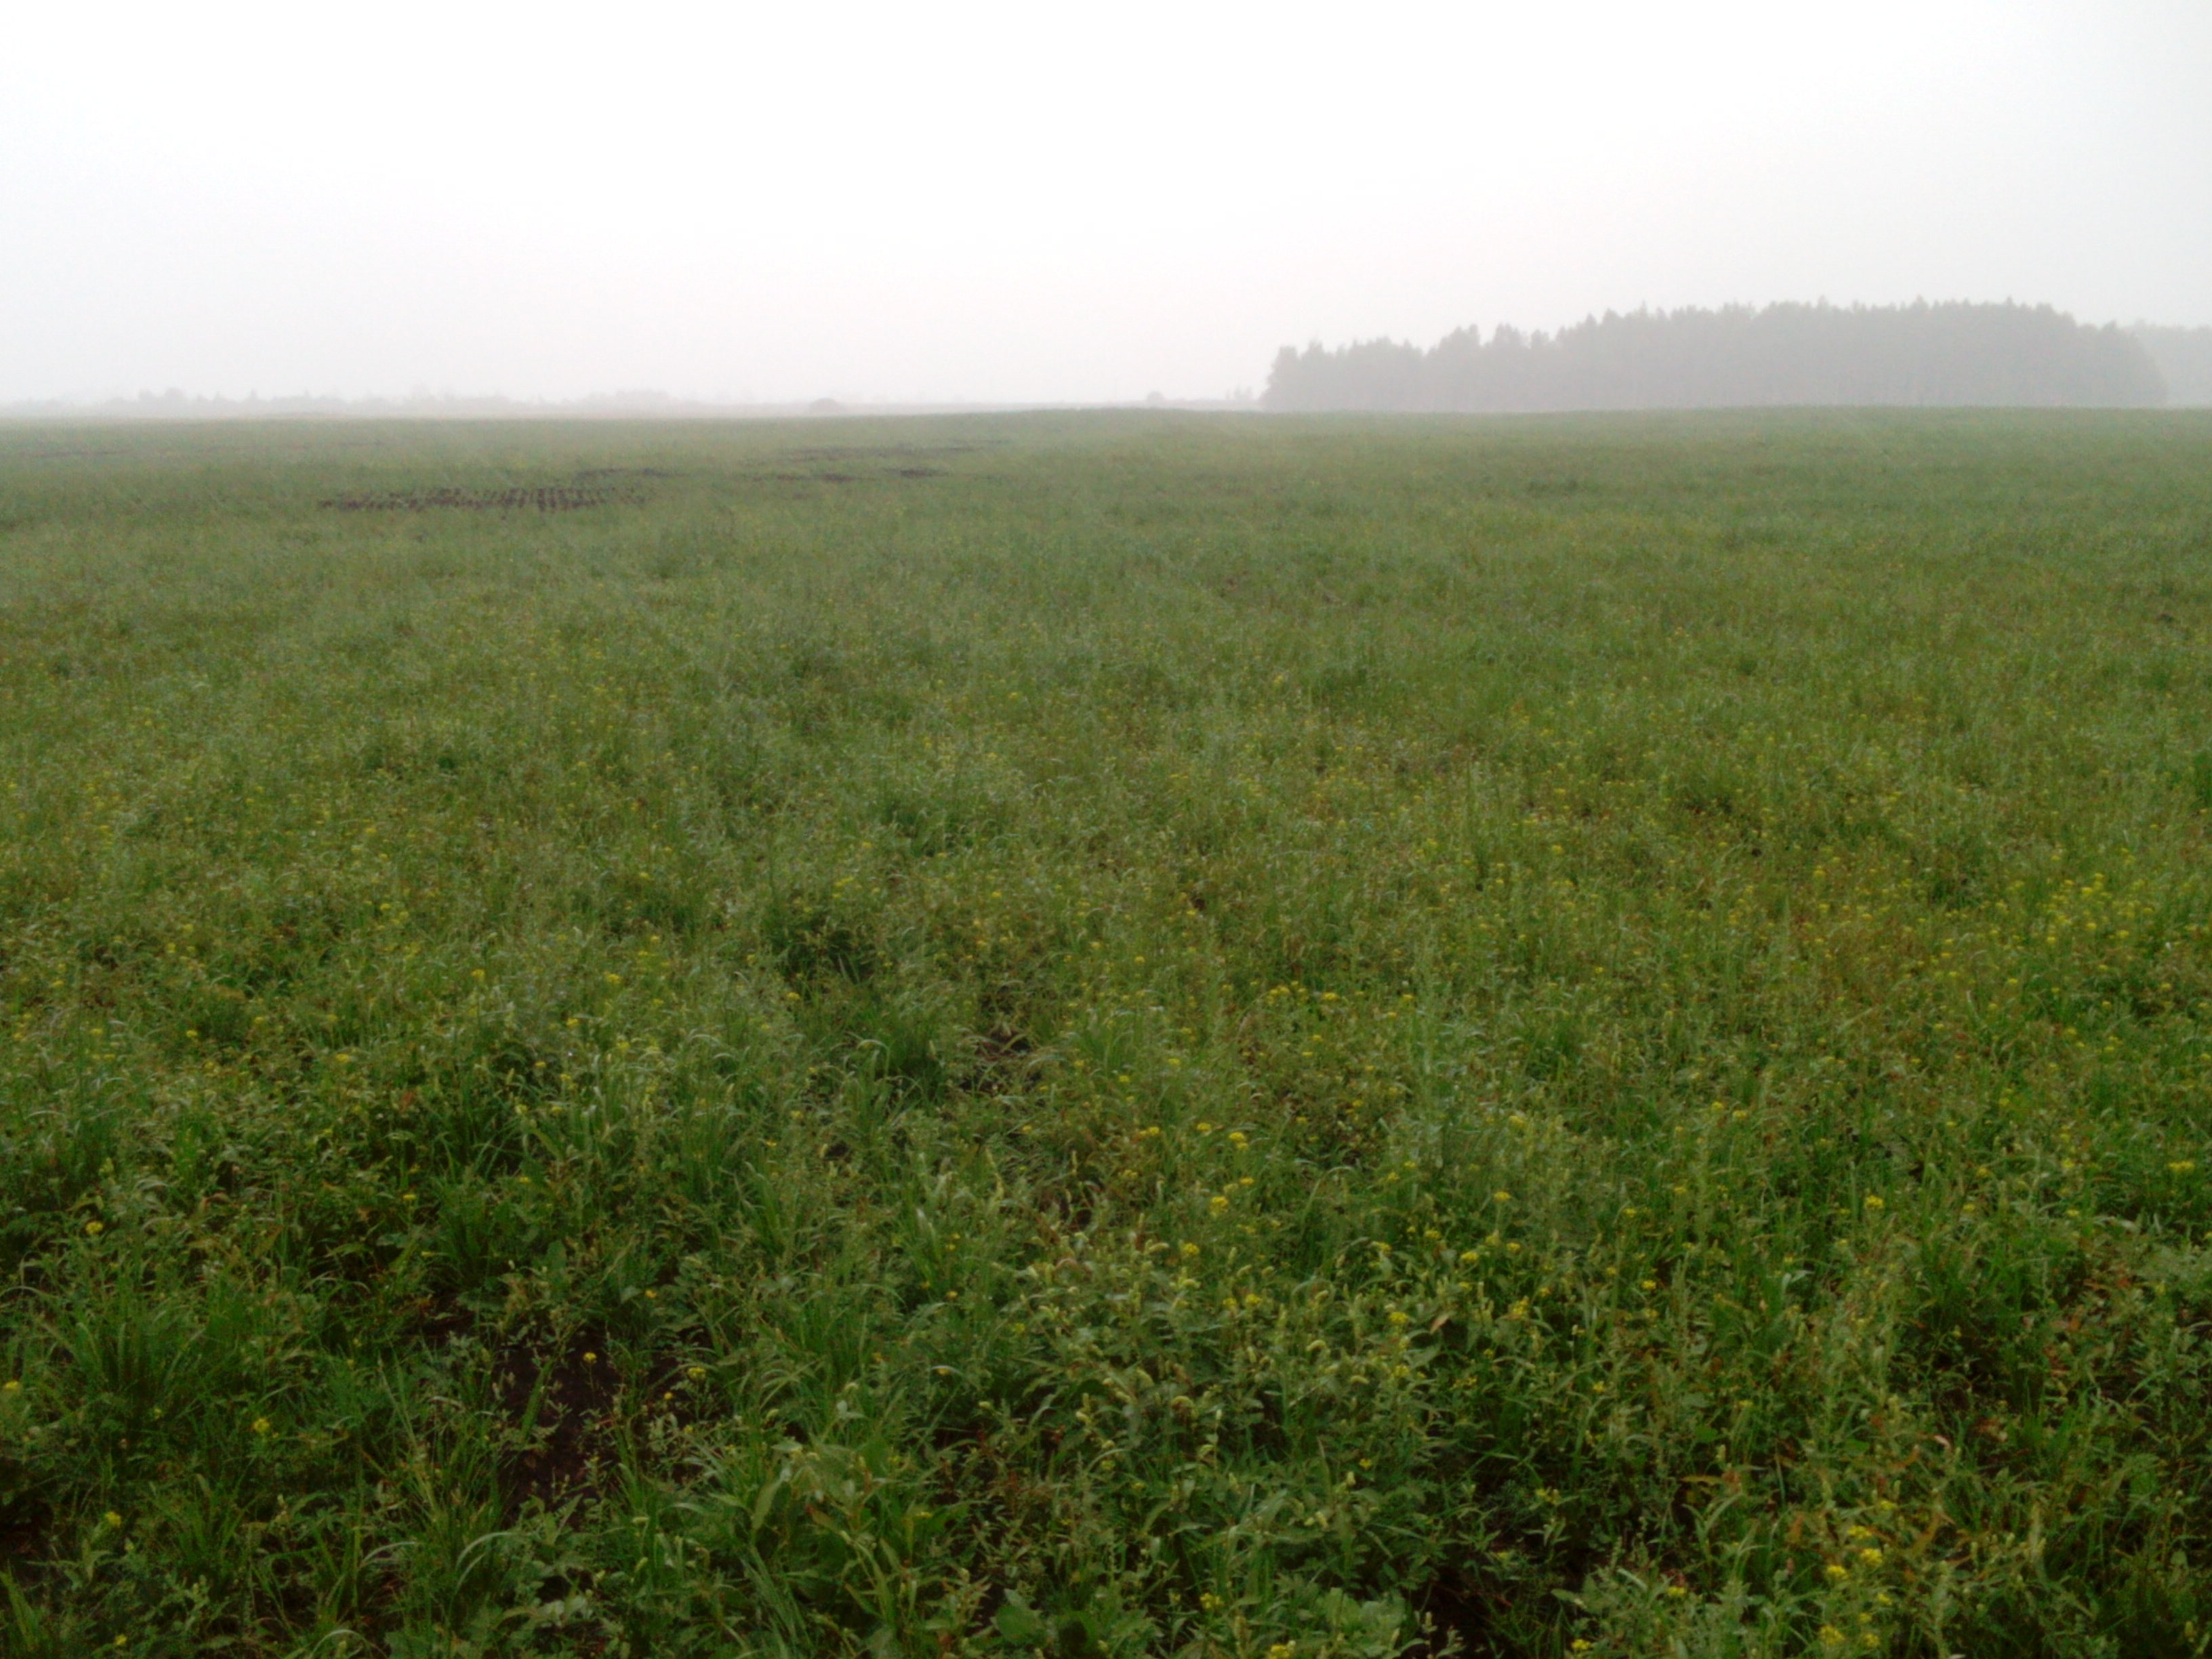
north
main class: Grassland
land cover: Spontaneously vegetated surfaces
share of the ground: > 75 %
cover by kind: herbaceous plants 100 %
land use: Fallow land
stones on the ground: < 10 %
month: September
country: LT
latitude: 55.9588
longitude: 22.4726
